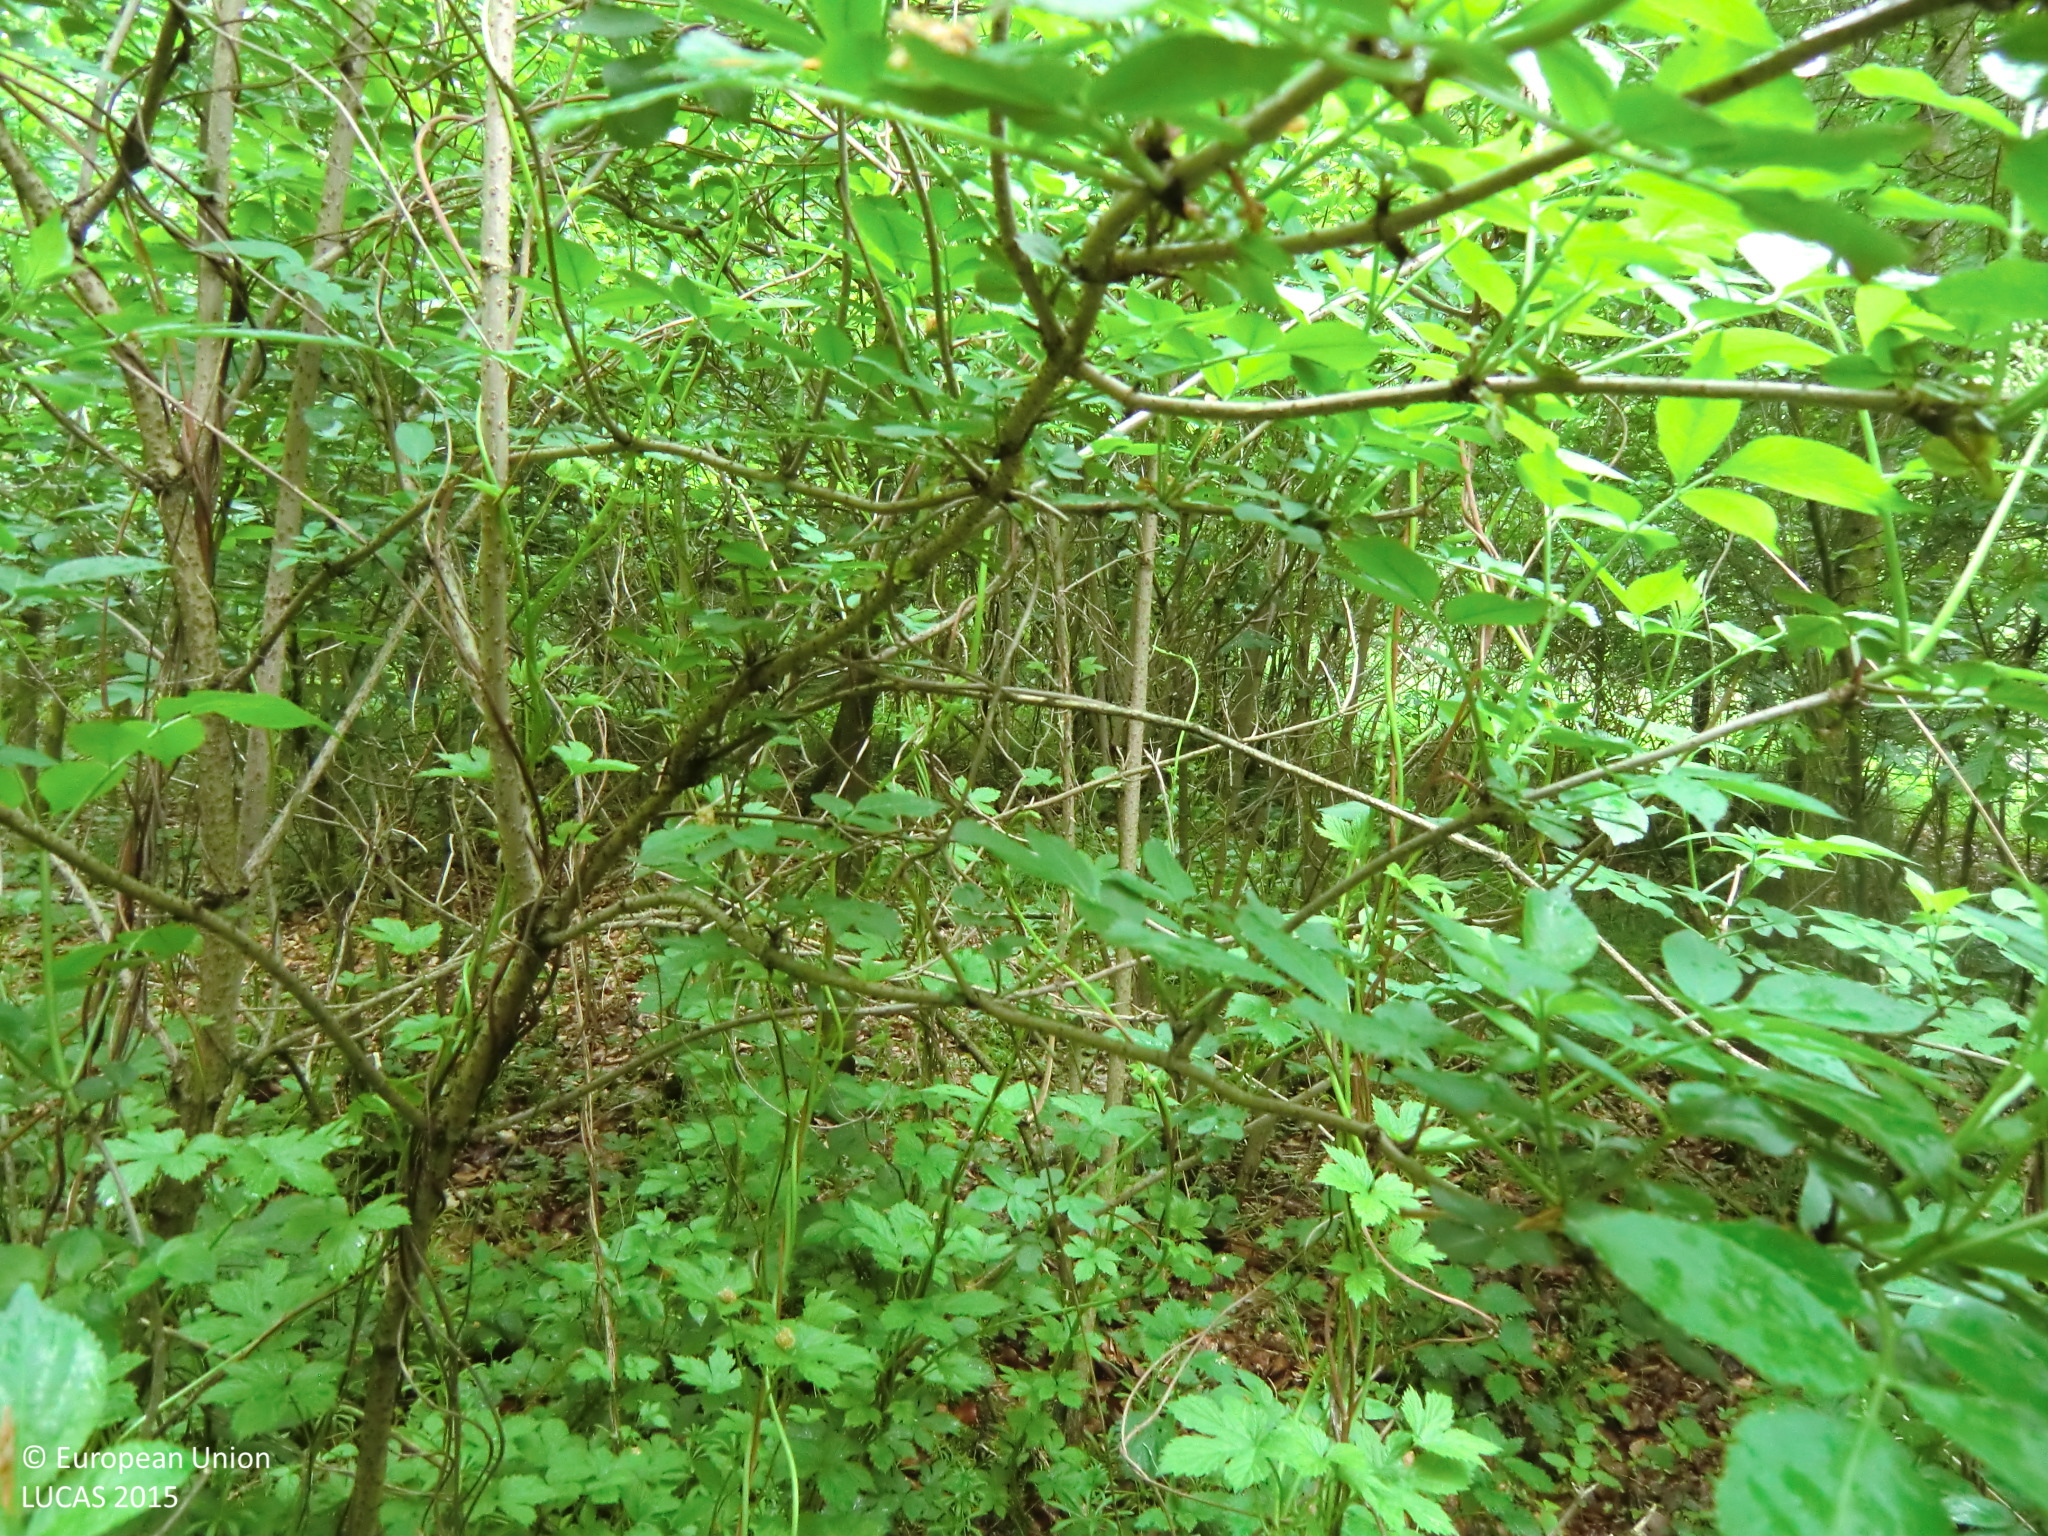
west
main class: Woodland
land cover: Other mixed woodland
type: mountainous beech forest
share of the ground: > 75 %
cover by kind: broadleaved forest trees 55 %, coniferous forest trees 30 %, shrubs 10 %, herbaceous plants 5 %
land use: Forestry
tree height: > 5 m
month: May
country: AT
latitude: 48.2113
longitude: 14.7512
